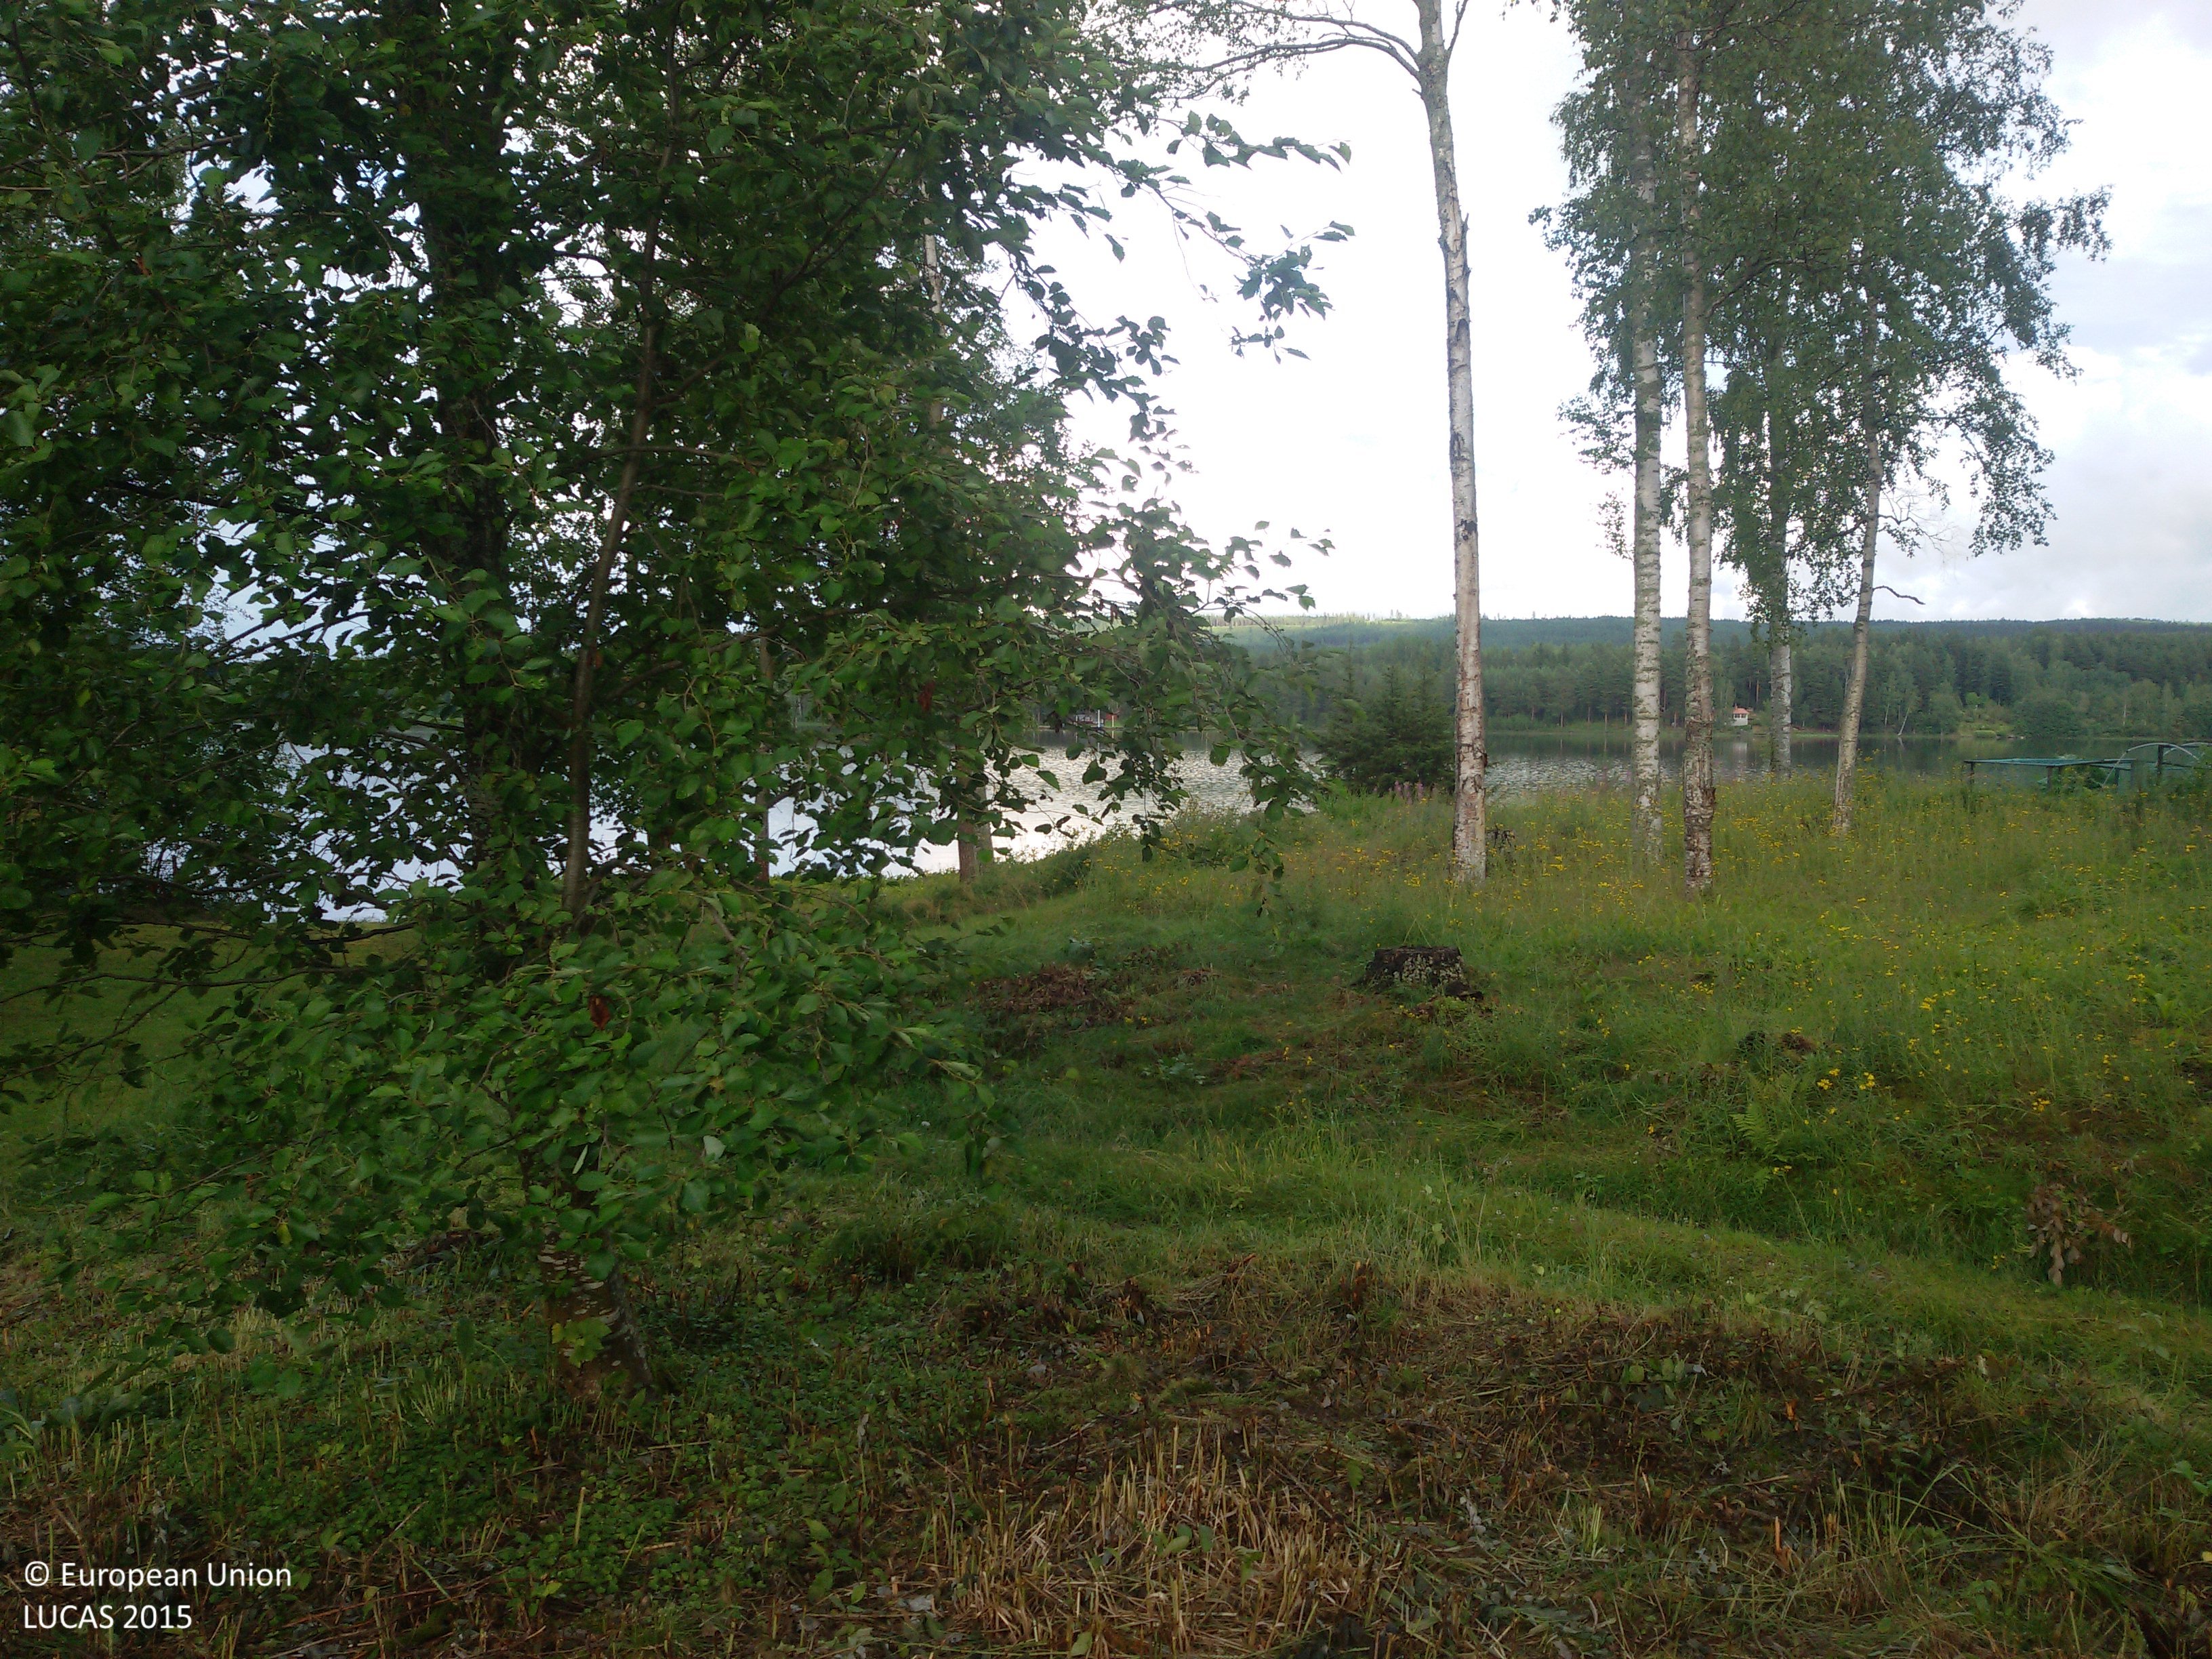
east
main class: Grassland
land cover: Grassland without tree/shrub cover
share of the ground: > 75 %
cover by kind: herbaceous plants 100 %
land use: Semi-natural and natural areas not in use
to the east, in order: Grassland without tree/shrub cover; Broadleaved woodland; Tracks; Groves; Broadleaved woodland; Grassland without tree/shrub cover; Inland fresh water bodies
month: July
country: SE
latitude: 60.5338
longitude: 15.7284
